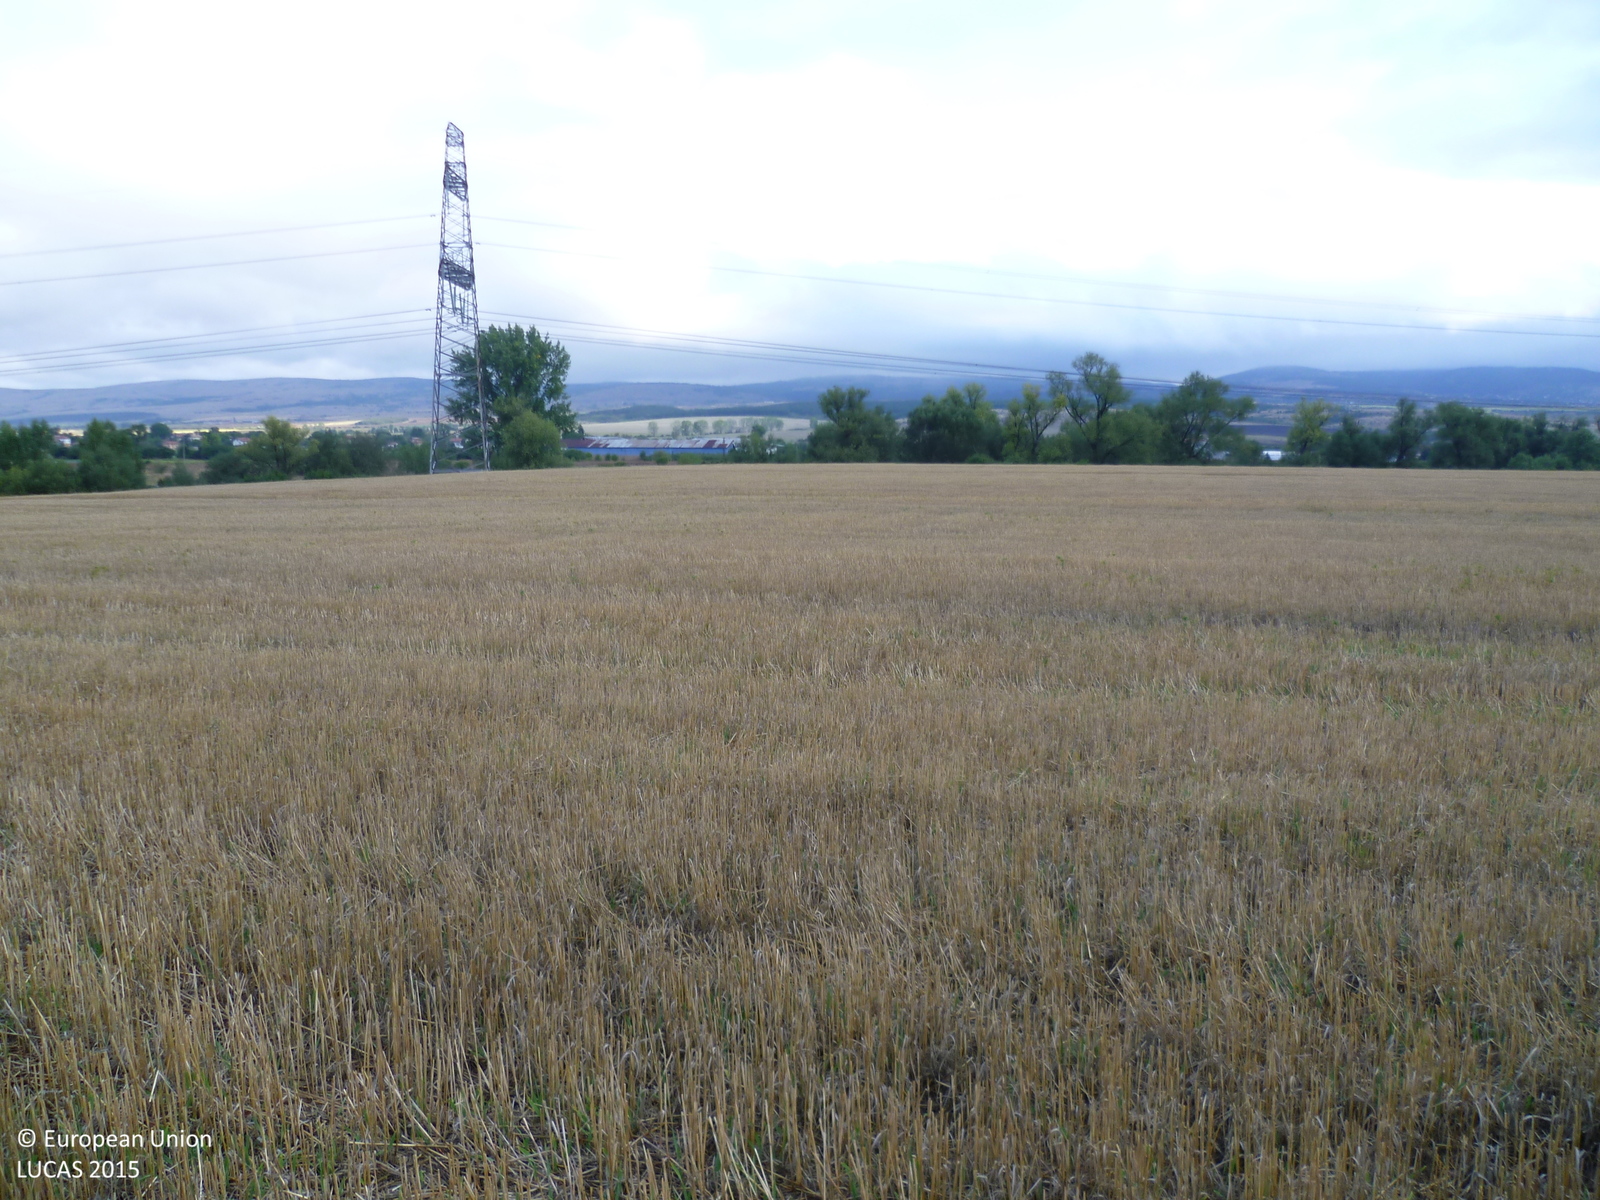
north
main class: Cropland
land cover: Rye
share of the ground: > 75 %
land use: Agriculture (excluding fallow land and kitchen gardens)
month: September
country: BG
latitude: 42.8327
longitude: 23.1599
